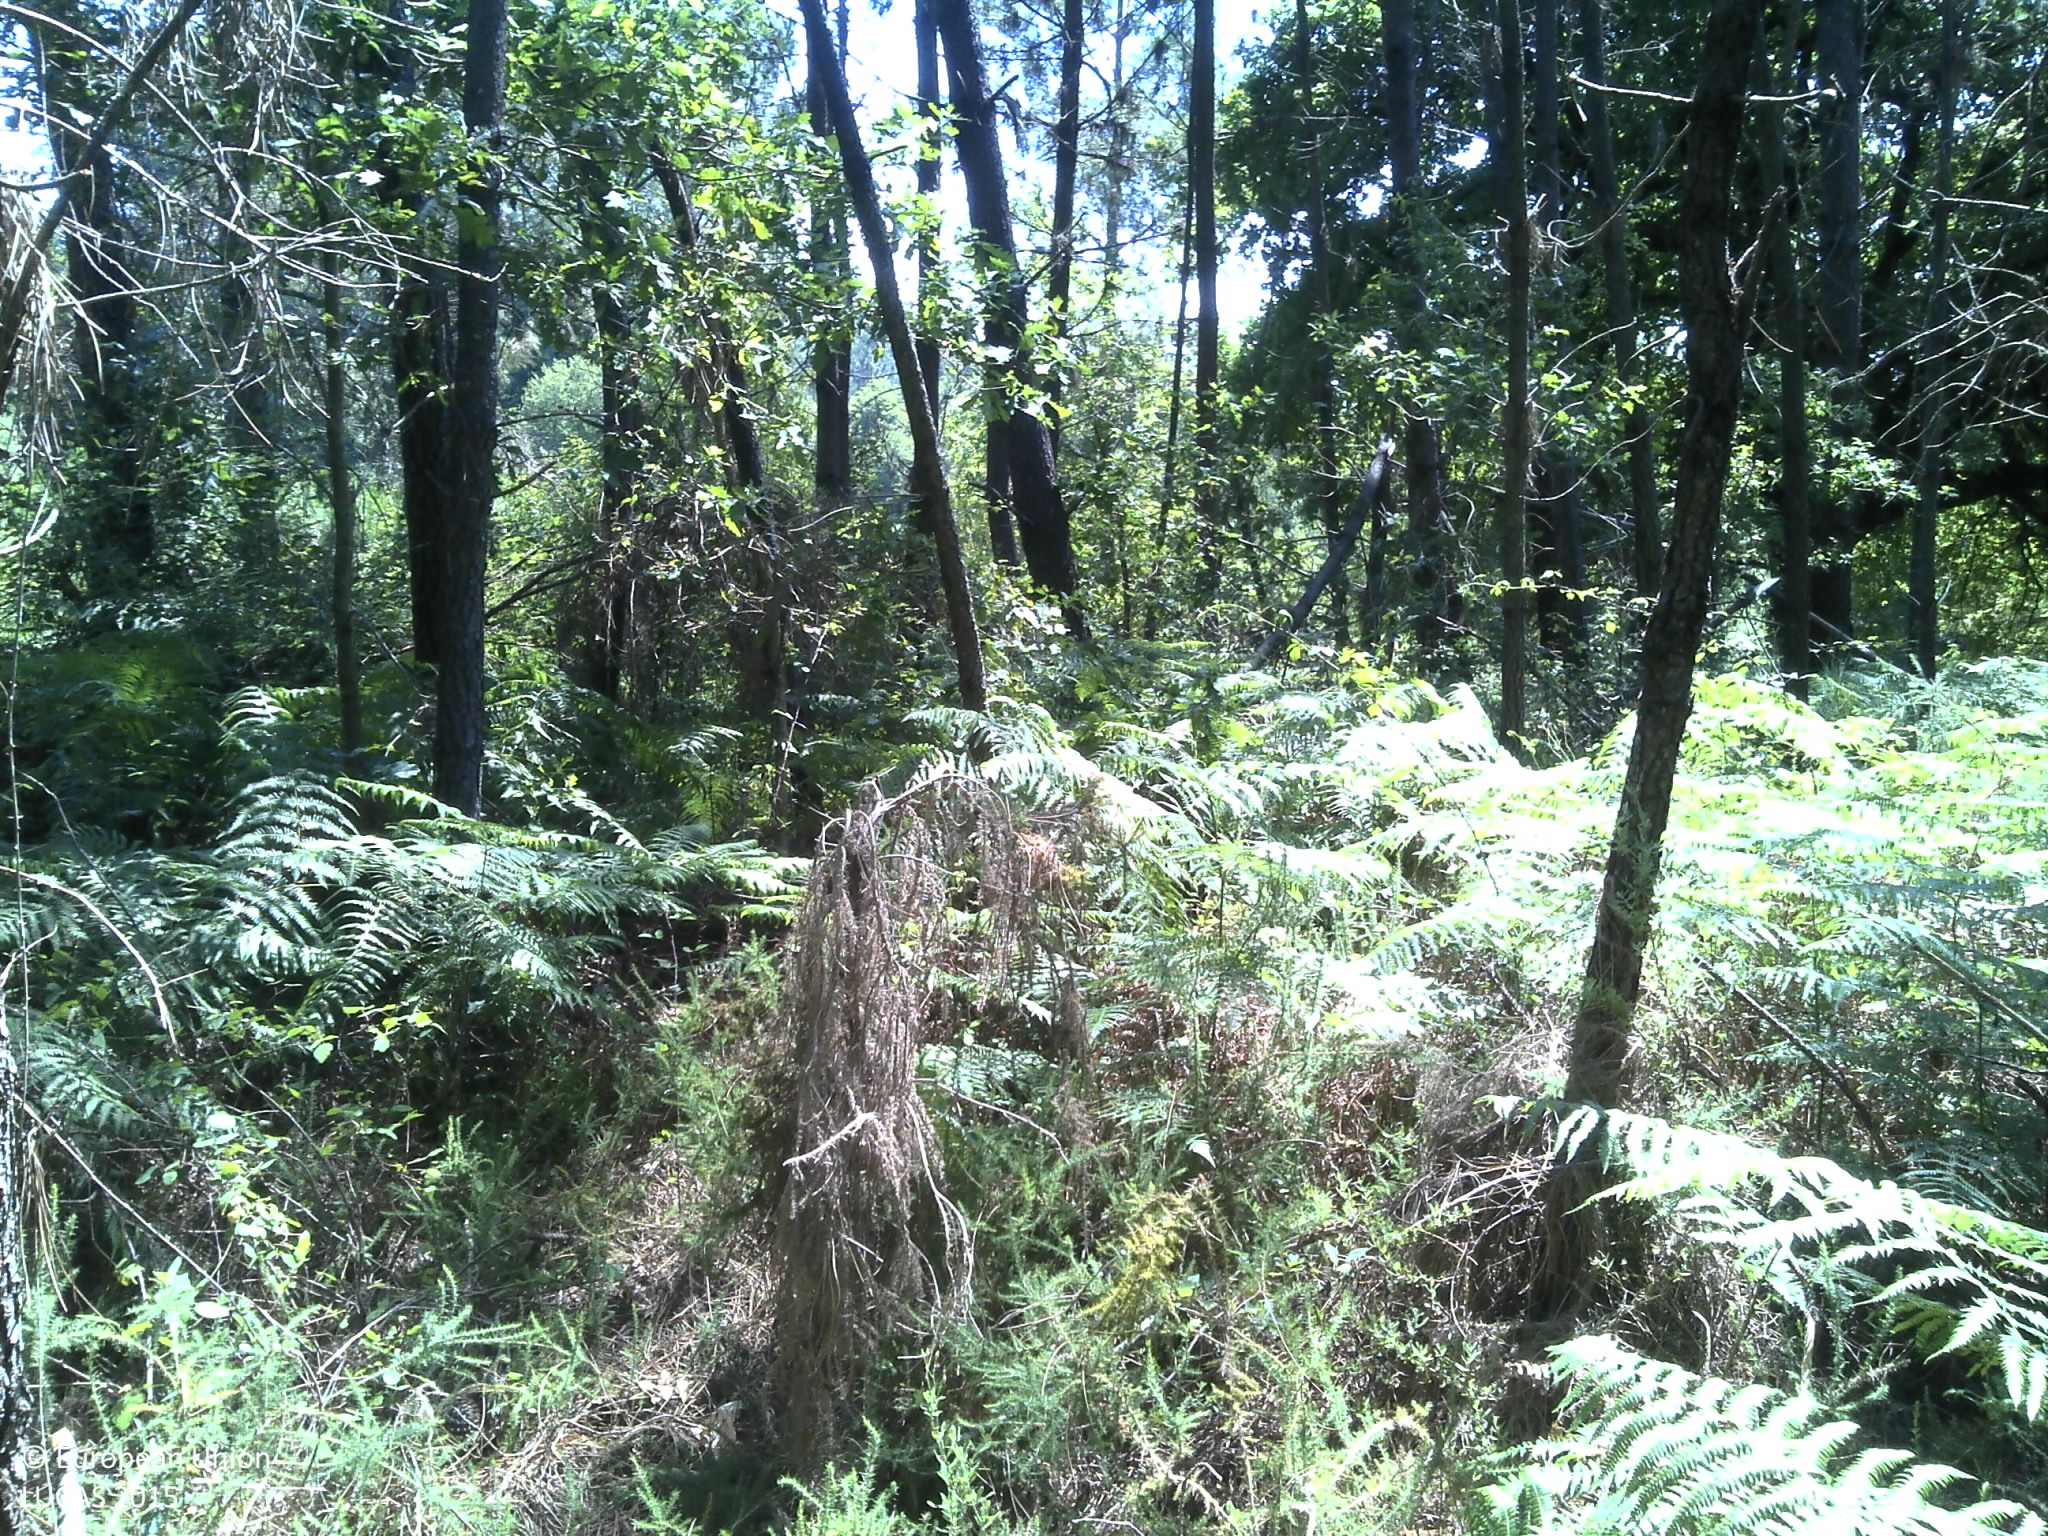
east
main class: Woodland
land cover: Pine dominated coniferous woodland
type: coniferous forest of the mediterranean region
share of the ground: 50 - 75 %
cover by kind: coniferous forest trees 60 %, shrubs 25 %, unconsolidated bare surface 10 %, herbaceous plants 5 %
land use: Forestry
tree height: > 5 m
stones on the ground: < 10 %
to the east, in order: Pine dominated coniferous woodland; Shrubland without tree cover; Shrubland with sparse tree cover; Spontaneously vegetated surfaces; Ditches and canals; Spontaneously vegetated surfaces; Broadleaved woodland; Shrubland without tree cover; Shrubland with sparse tree cover
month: June
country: PT
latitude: 40.5606
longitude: -8.0183
